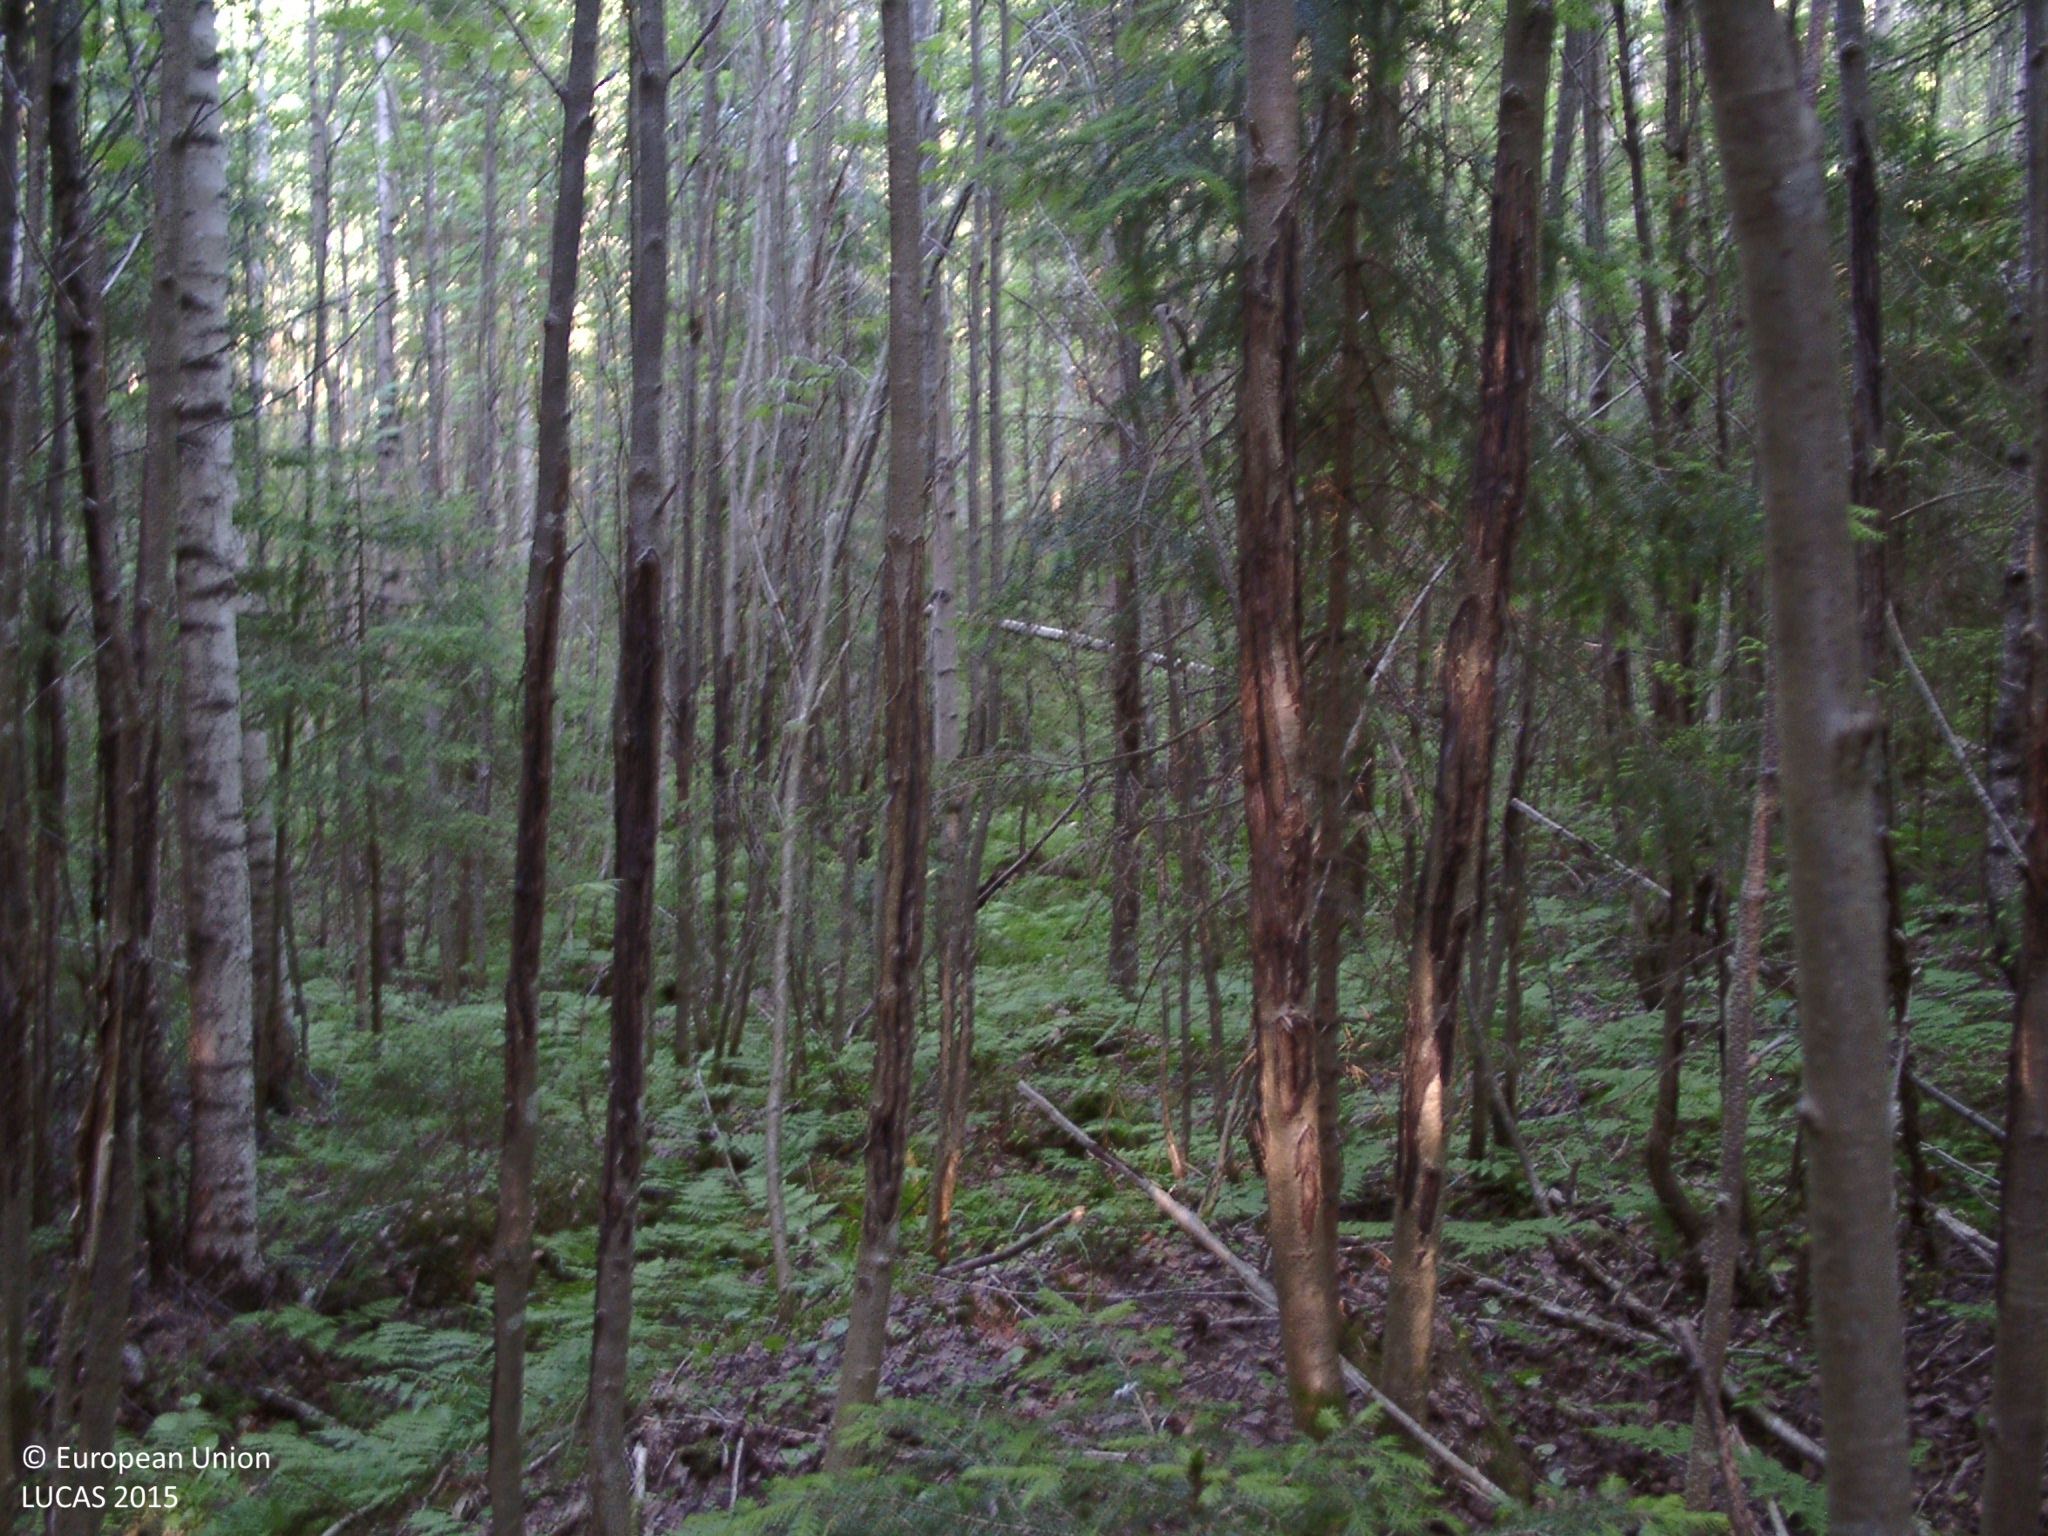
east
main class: Woodland
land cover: Spruce dominated mixed woodland
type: boreal forest
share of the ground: > 75 %
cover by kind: coniferous forest trees 50 %, broadleaved forest trees 40 %, herbaceous plants 5 %, lichens and mosses 5 %
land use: Semi-natural and natural areas not in use
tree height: > 5 m
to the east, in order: Spruce dominated mixed woodland; Spruce dominated coniferous woodland; Spruce dominated mixed woodland; Broadleaved woodland; Spruce dominated mixed woodland
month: July
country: FI
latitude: 61.9751
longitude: 25.4351
